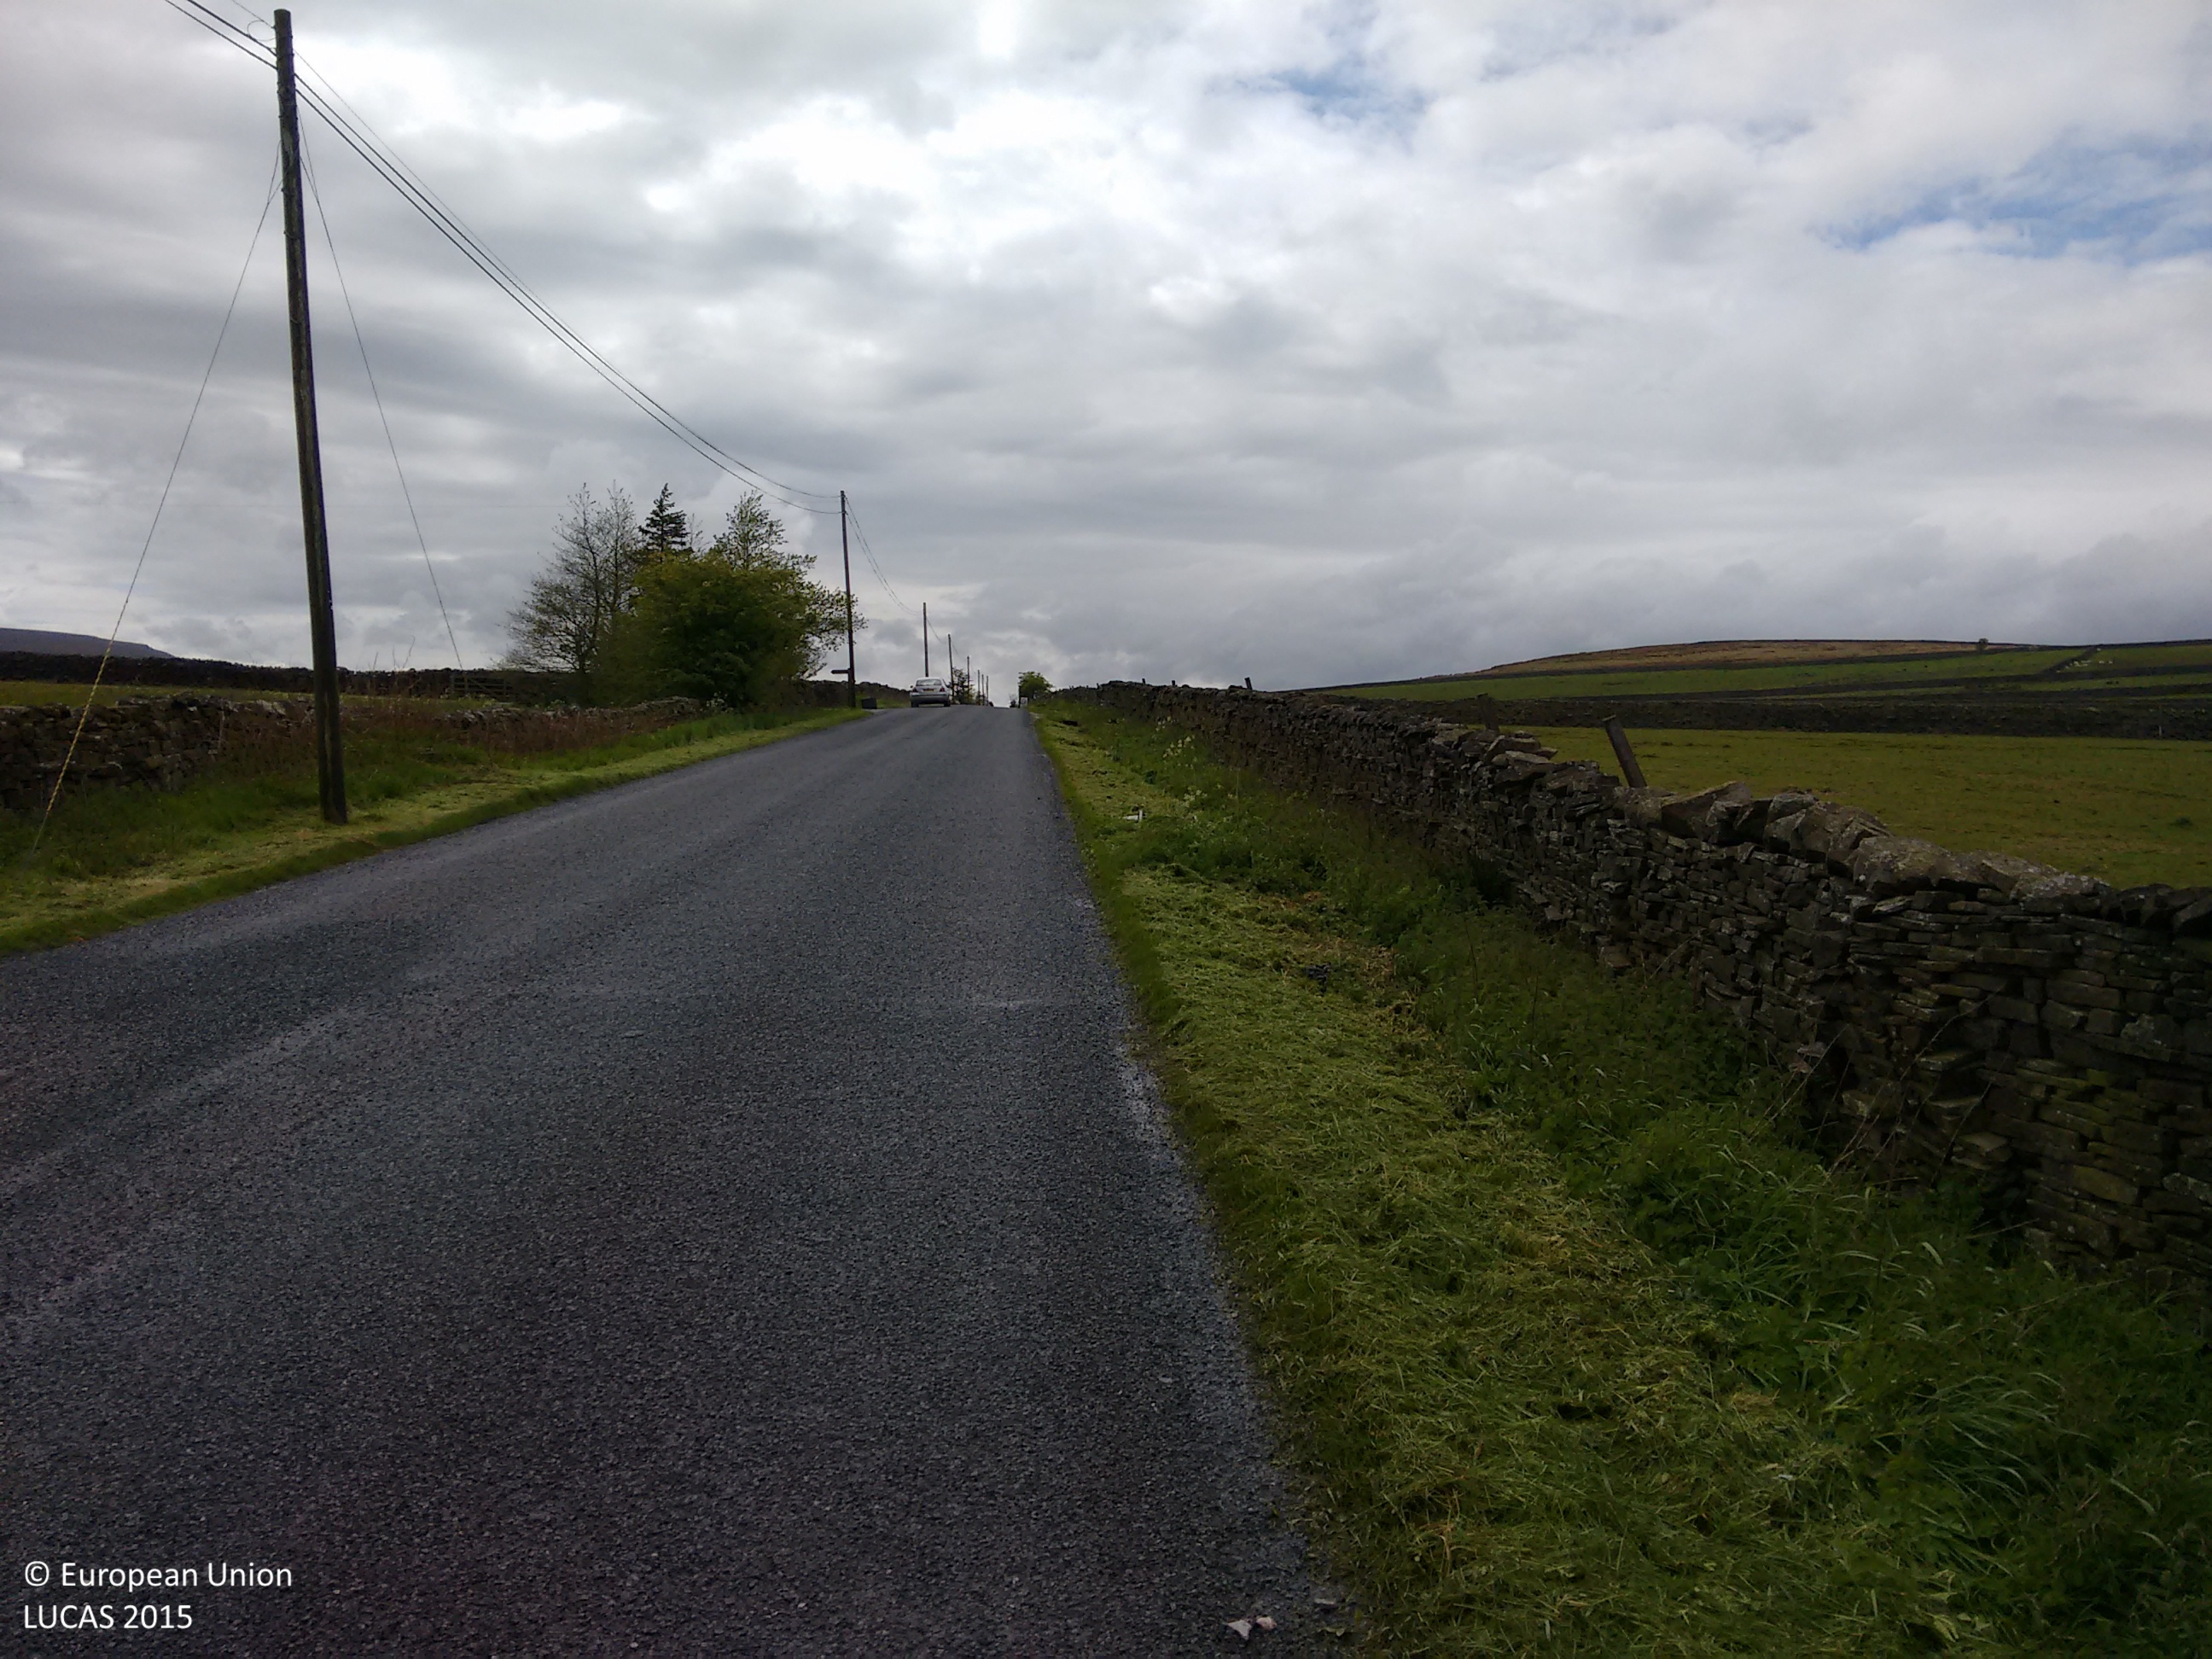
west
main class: Grassland
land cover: Grassland without tree/shrub cover
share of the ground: > 75 %
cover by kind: herbaceous plants 100 %
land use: Agriculture (excluding fallow land and kitchen gardens)
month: June
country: GB
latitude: 54.0646
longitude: -1.9275
